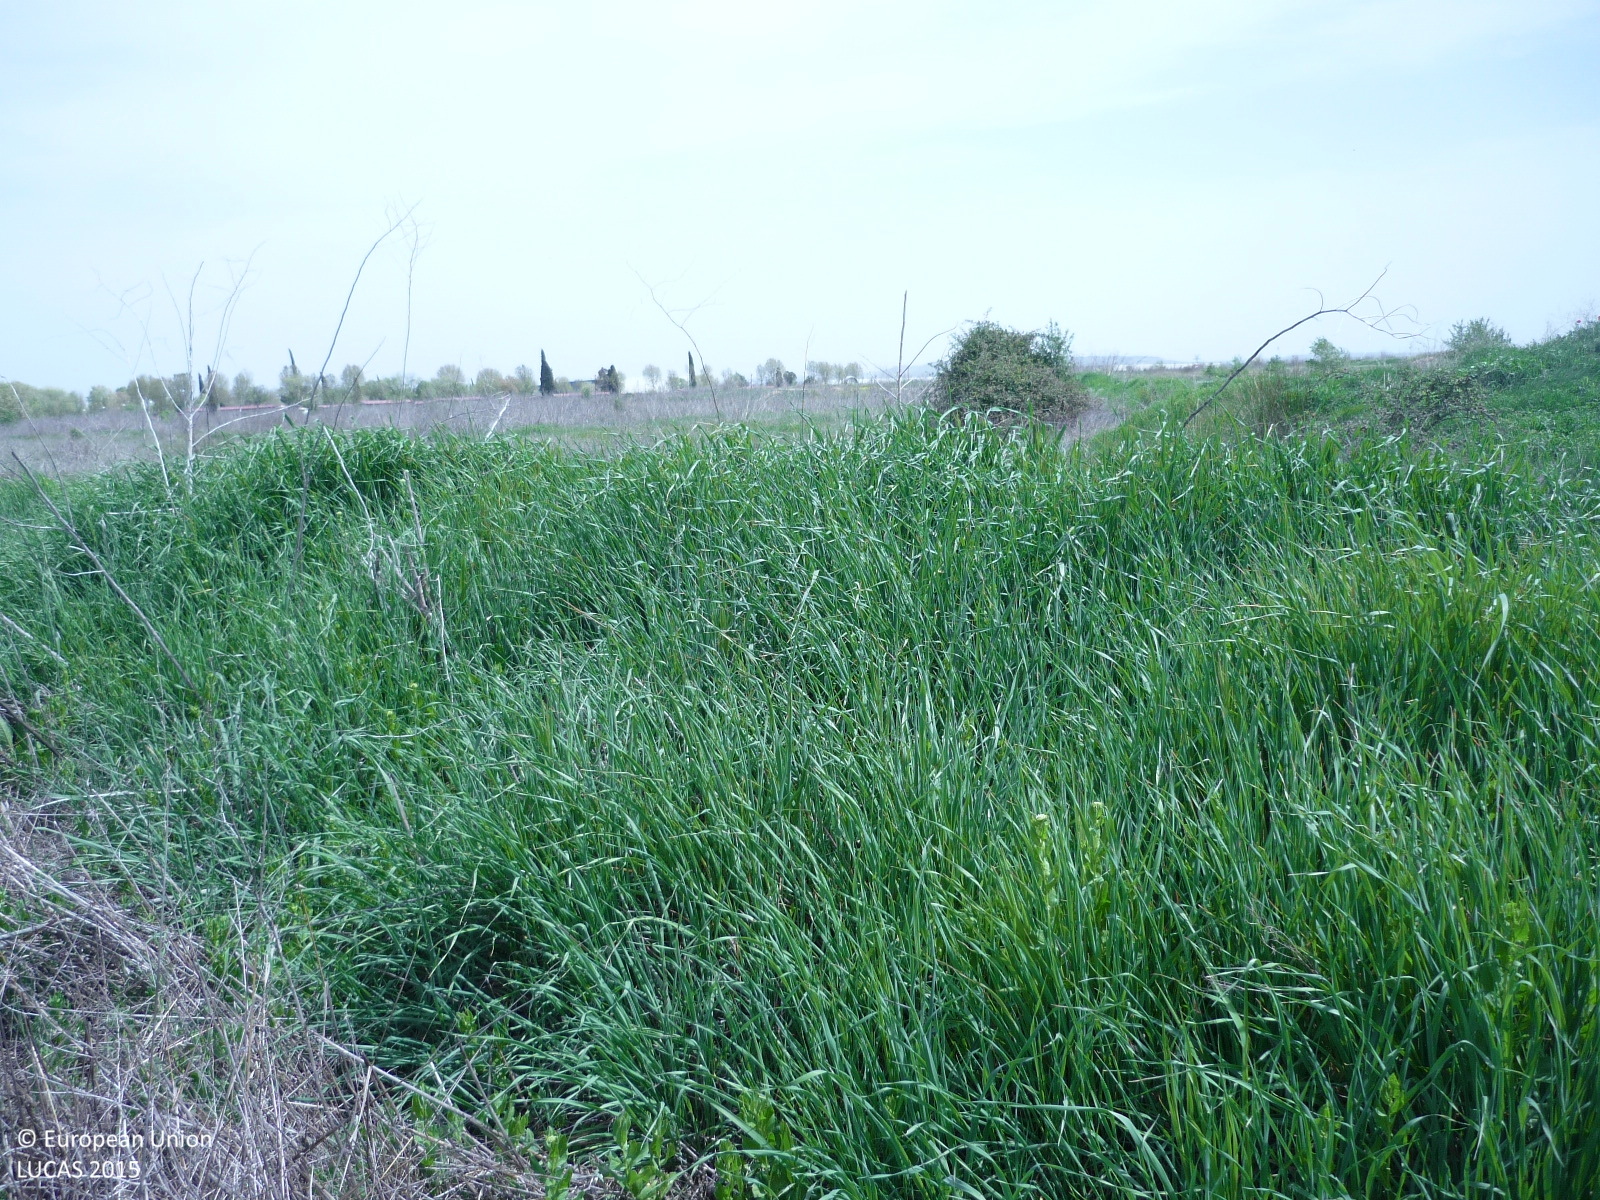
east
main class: Grassland
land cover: Grassland without tree/shrub cover
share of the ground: > 75 %
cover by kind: herbaceous plants 80 %, consolidated bare surface 20 %
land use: Abandoned areas
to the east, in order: Grassland without tree/shrub cover; Tracks; Grassland without tree/shrub cover
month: April
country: ES
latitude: 40.4724
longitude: -3.4457
